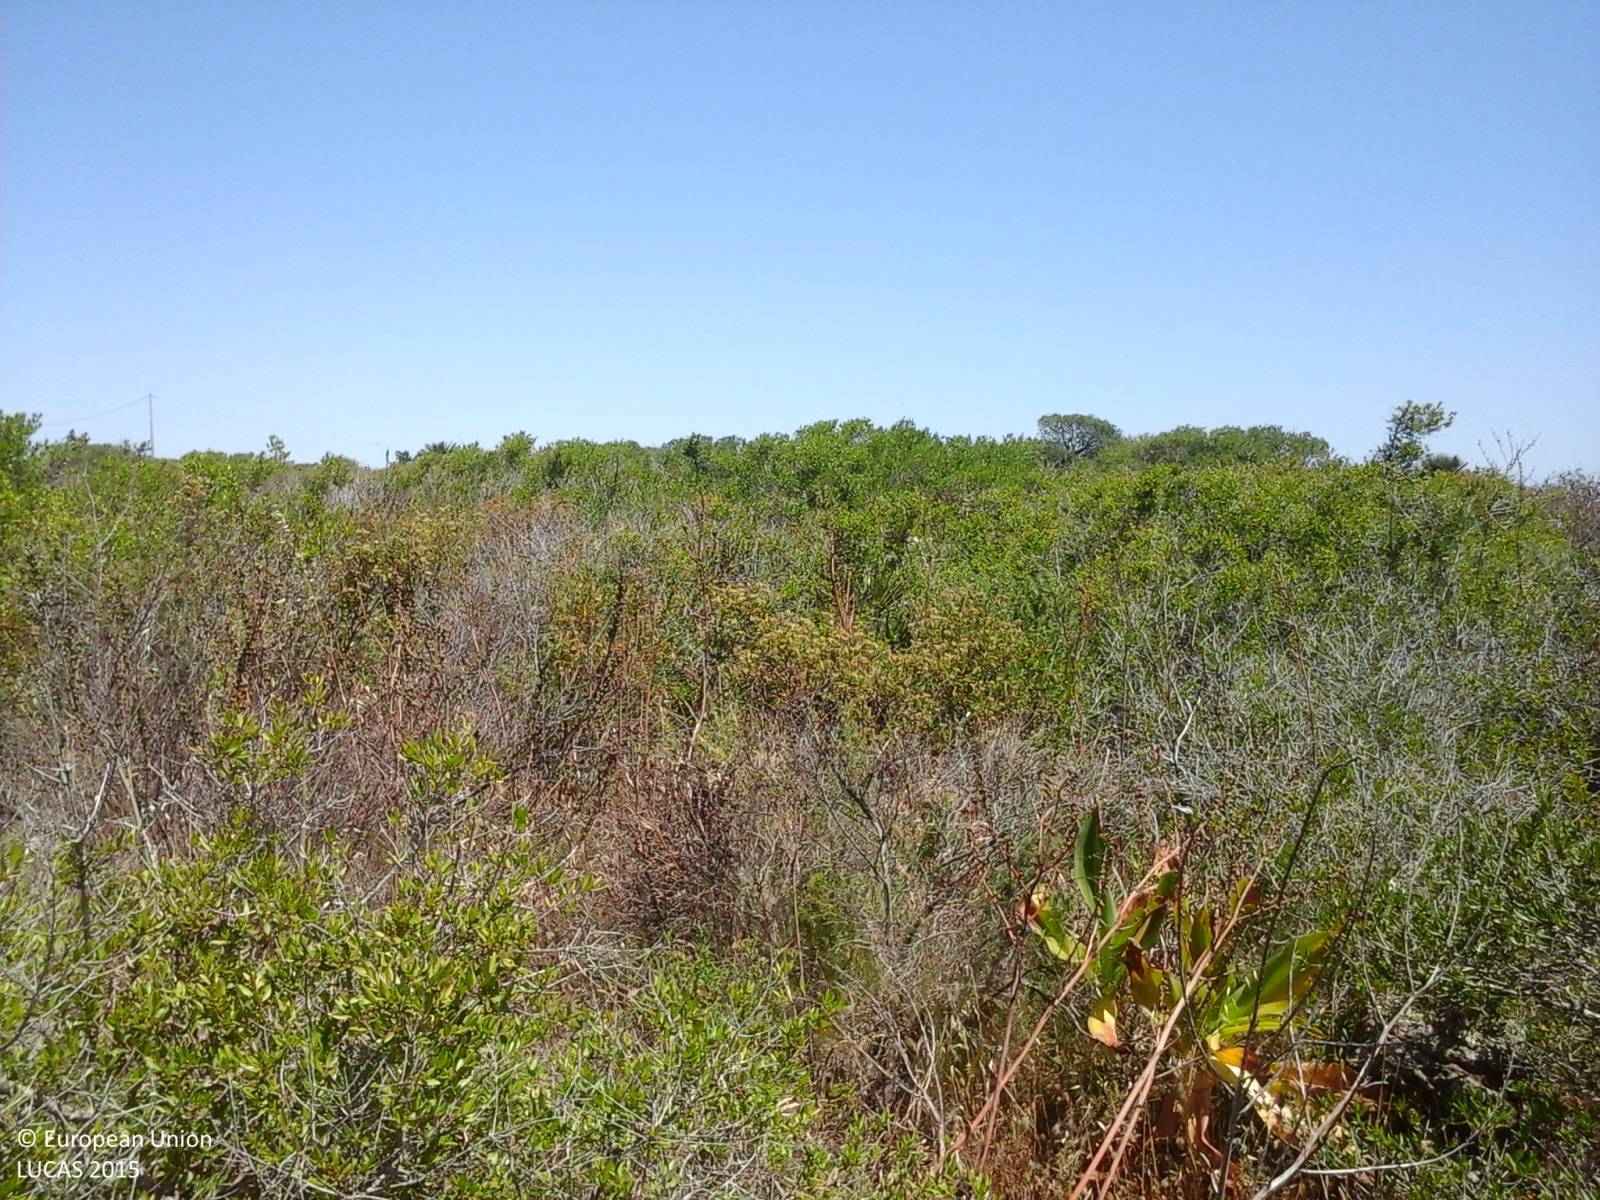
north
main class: Shrubland
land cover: Shrubland without tree cover
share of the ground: > 75 %
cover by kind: shrubs 80 %, herbaceous plants 20 %
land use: Semi-natural and natural areas not in use
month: May
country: IT
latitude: 40.6354
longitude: 8.4586
